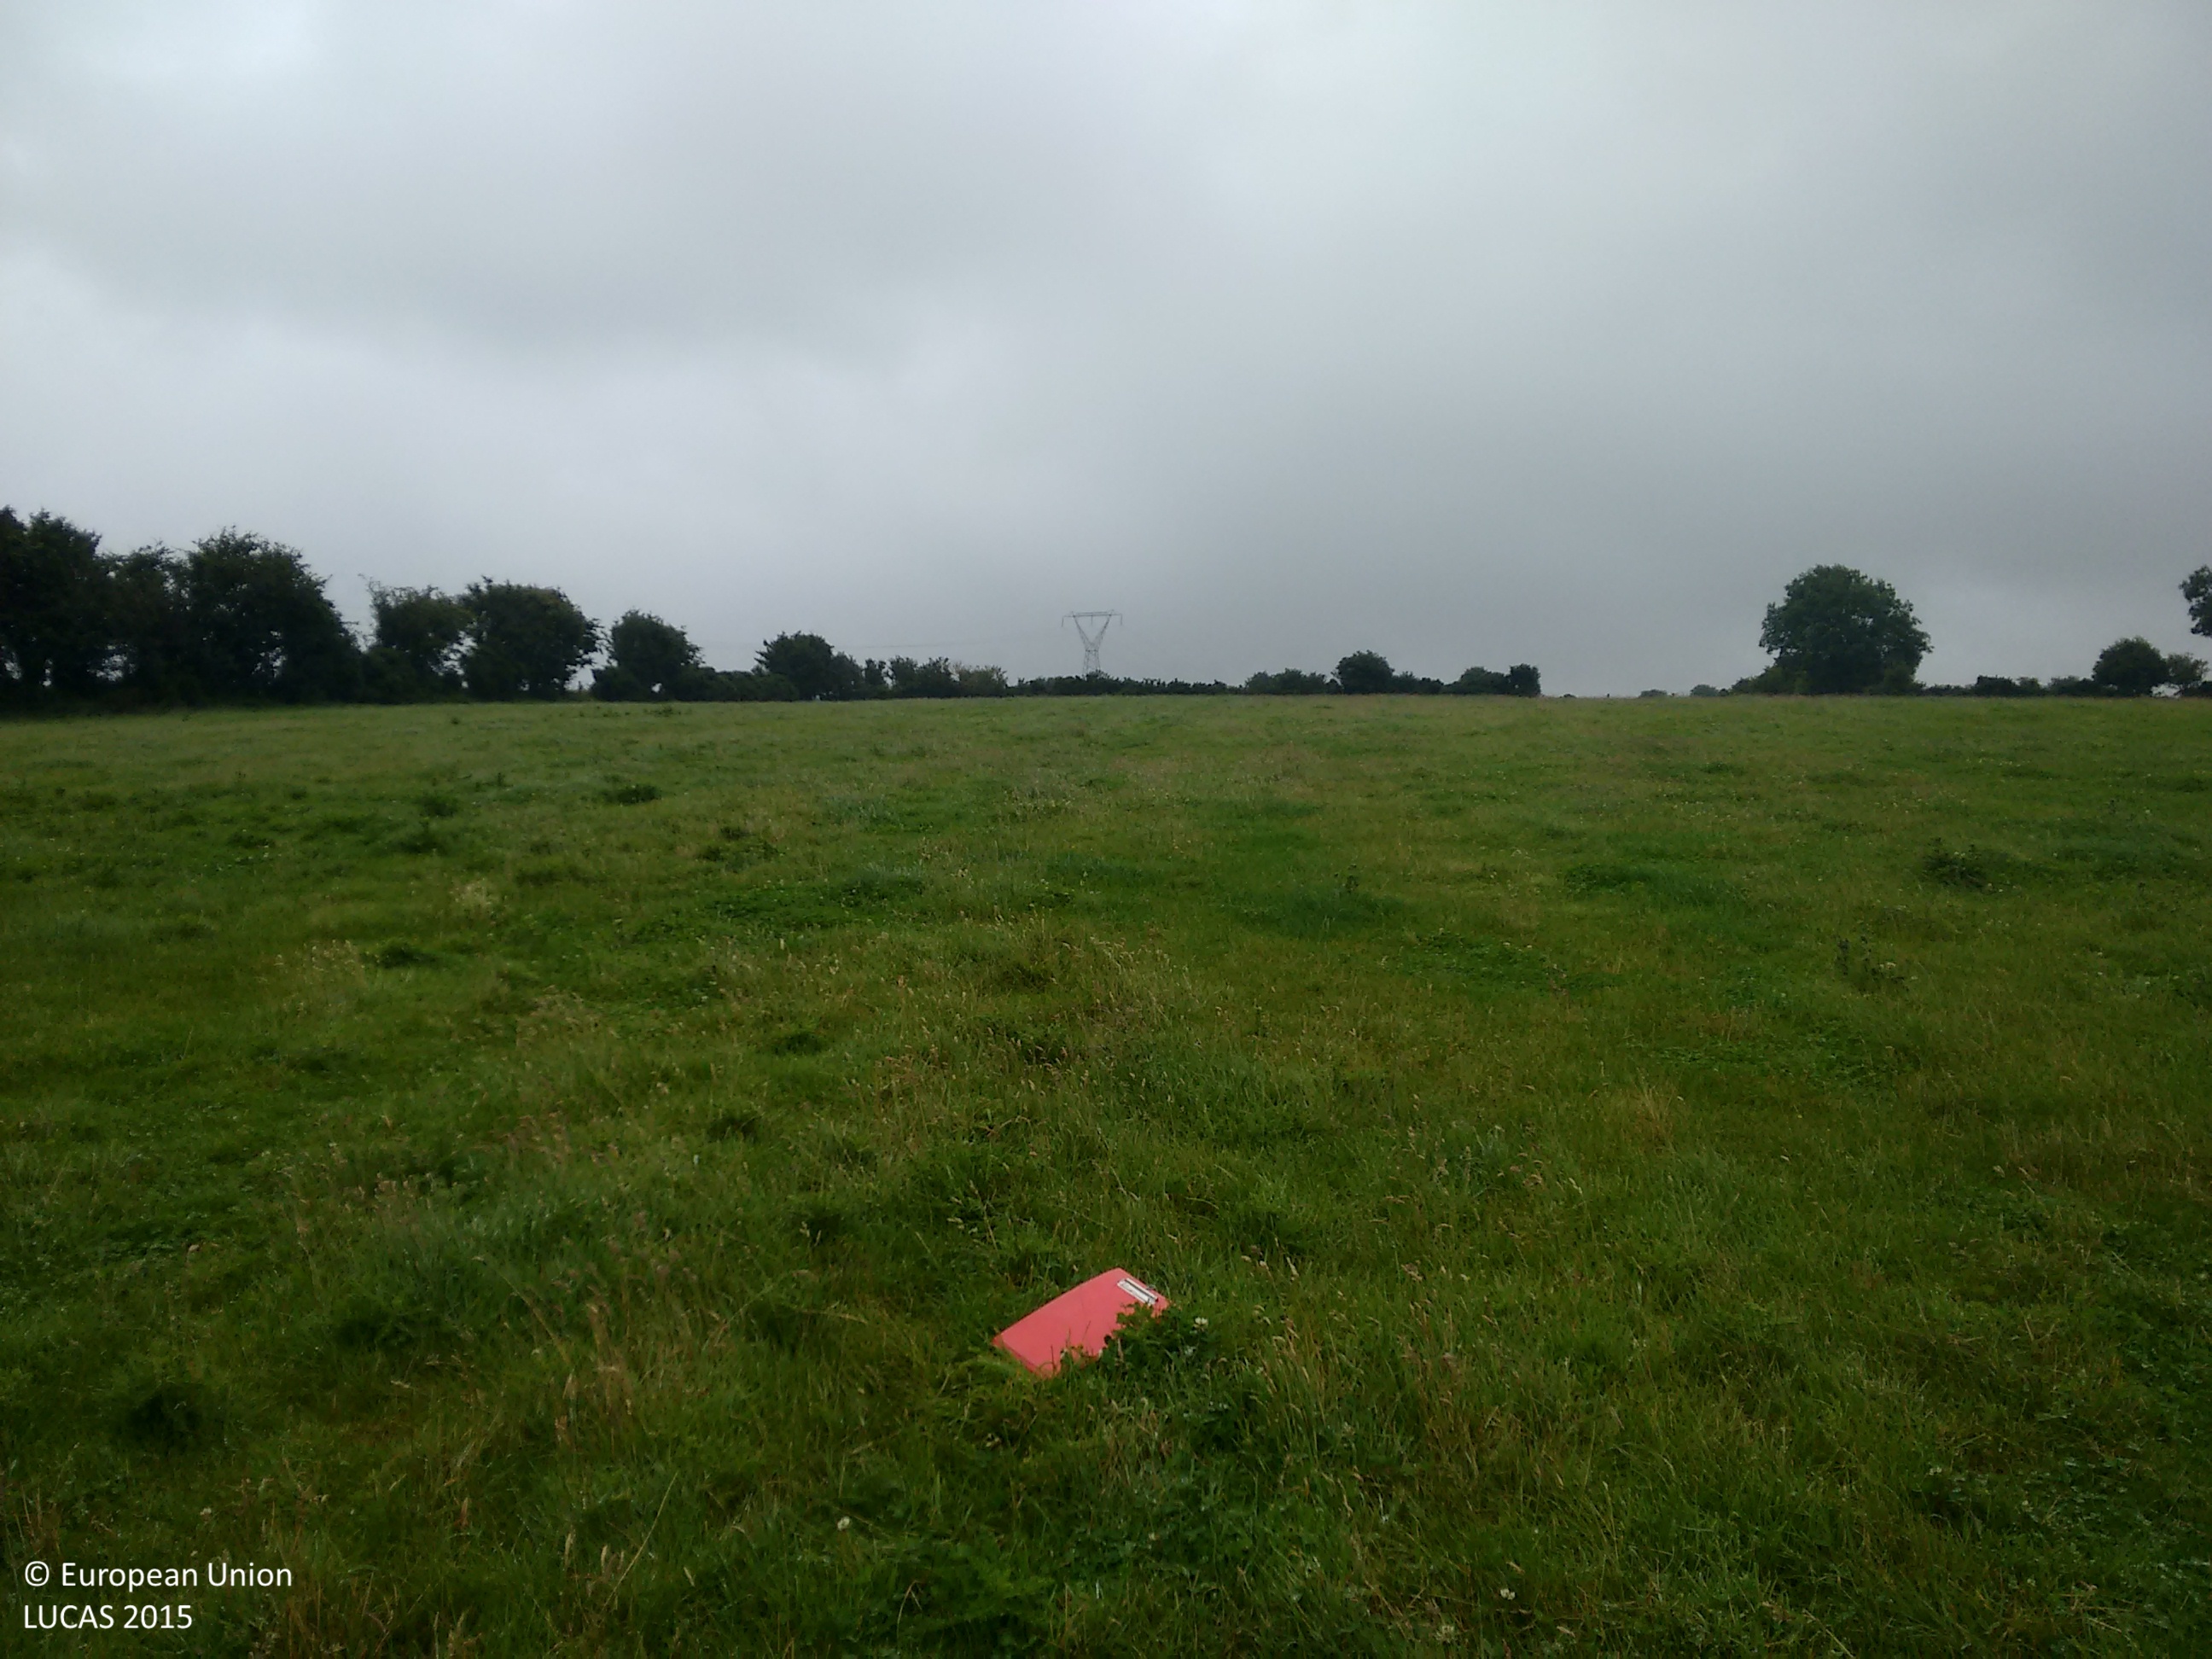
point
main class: Grassland
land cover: Grassland without tree/shrub cover
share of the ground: > 75 %
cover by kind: herbaceous plants 100 %
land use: Agriculture (excluding fallow land and kitchen gardens)
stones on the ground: < 10 %
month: August
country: IE
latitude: 52.6795
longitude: -6.3796
